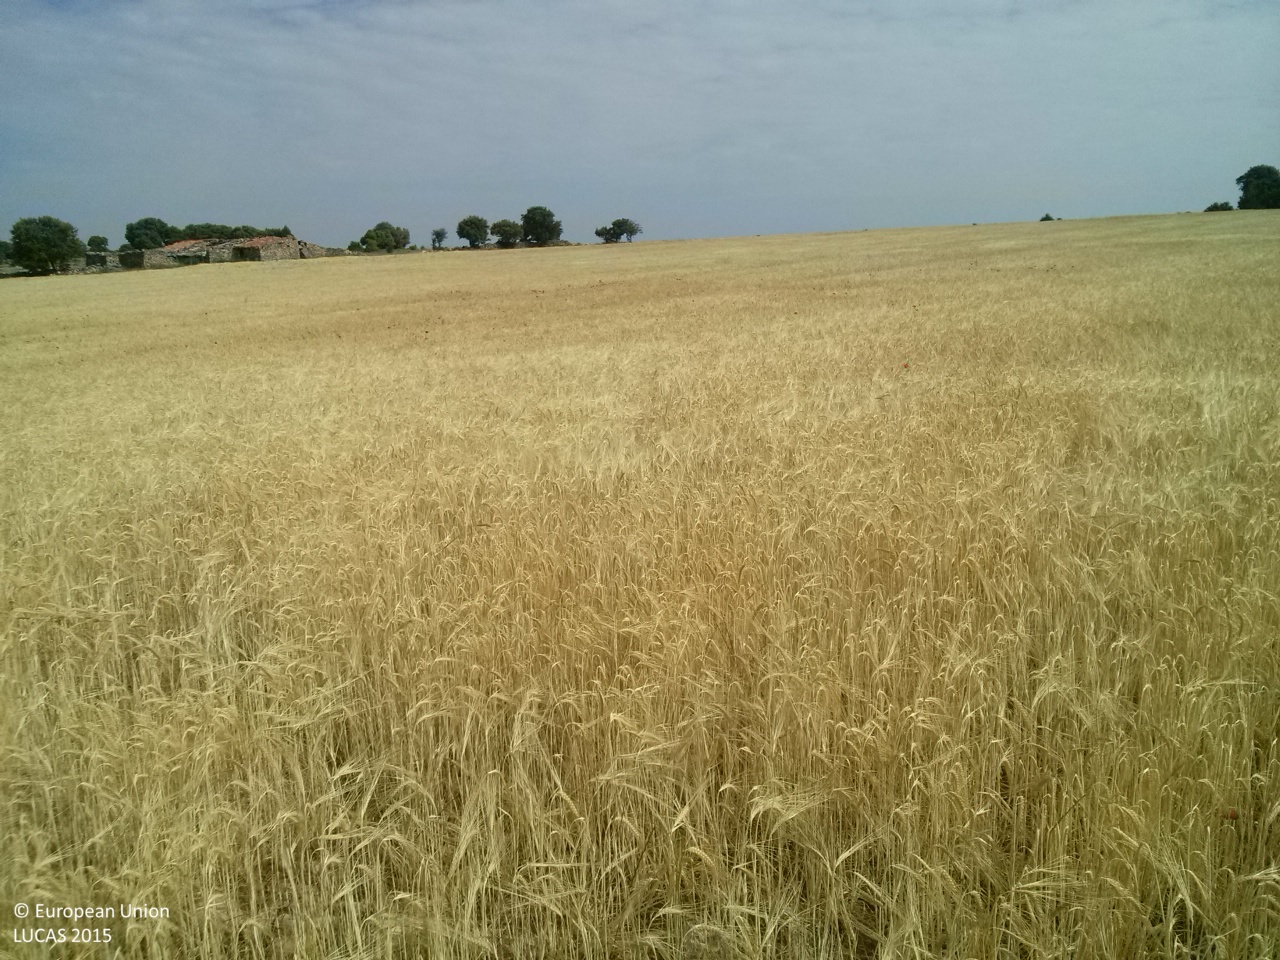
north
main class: Cropland
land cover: Barley
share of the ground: > 75 %
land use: Agriculture (excluding fallow land and kitchen gardens)
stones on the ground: 25 - 50 %
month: June
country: ES
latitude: 39.9583
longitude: -1.9177
